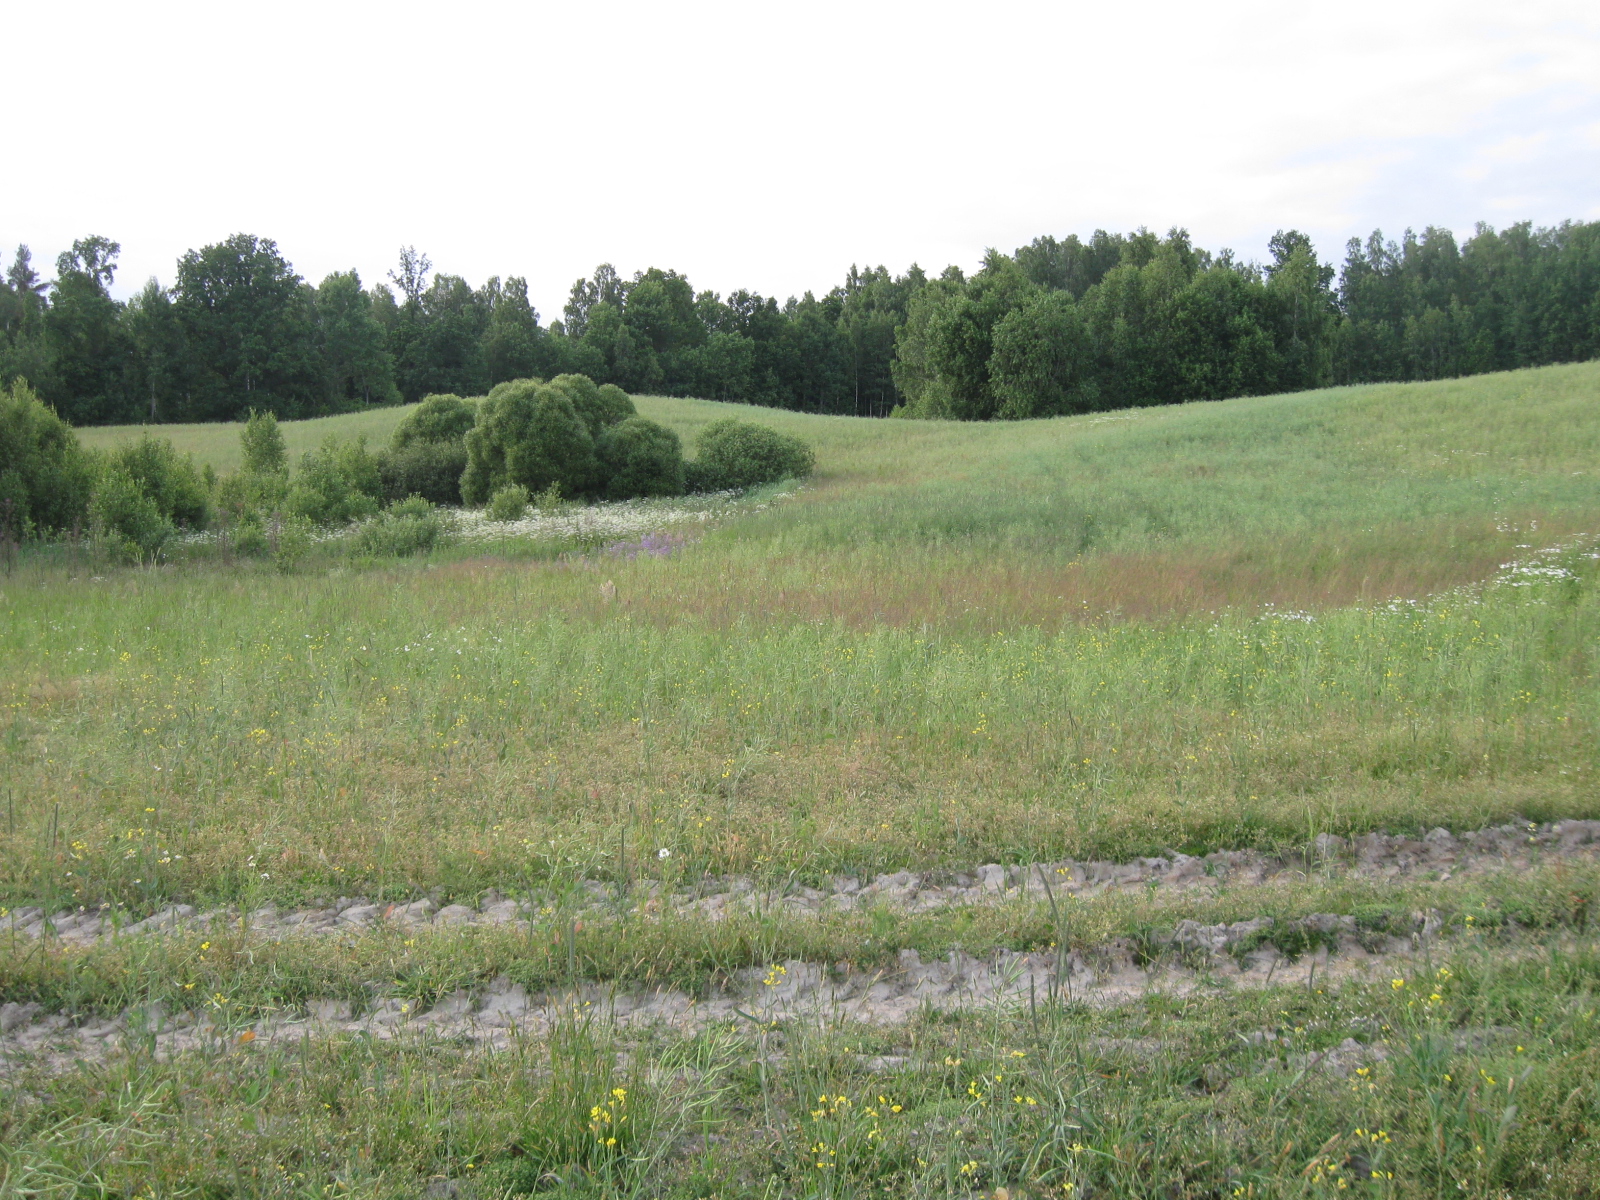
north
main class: Cropland
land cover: Rape and turnip rape
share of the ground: > 75 %
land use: Agriculture (excluding fallow land and kitchen gardens)
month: June
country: LT
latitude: 54.4123
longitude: 24.6049
